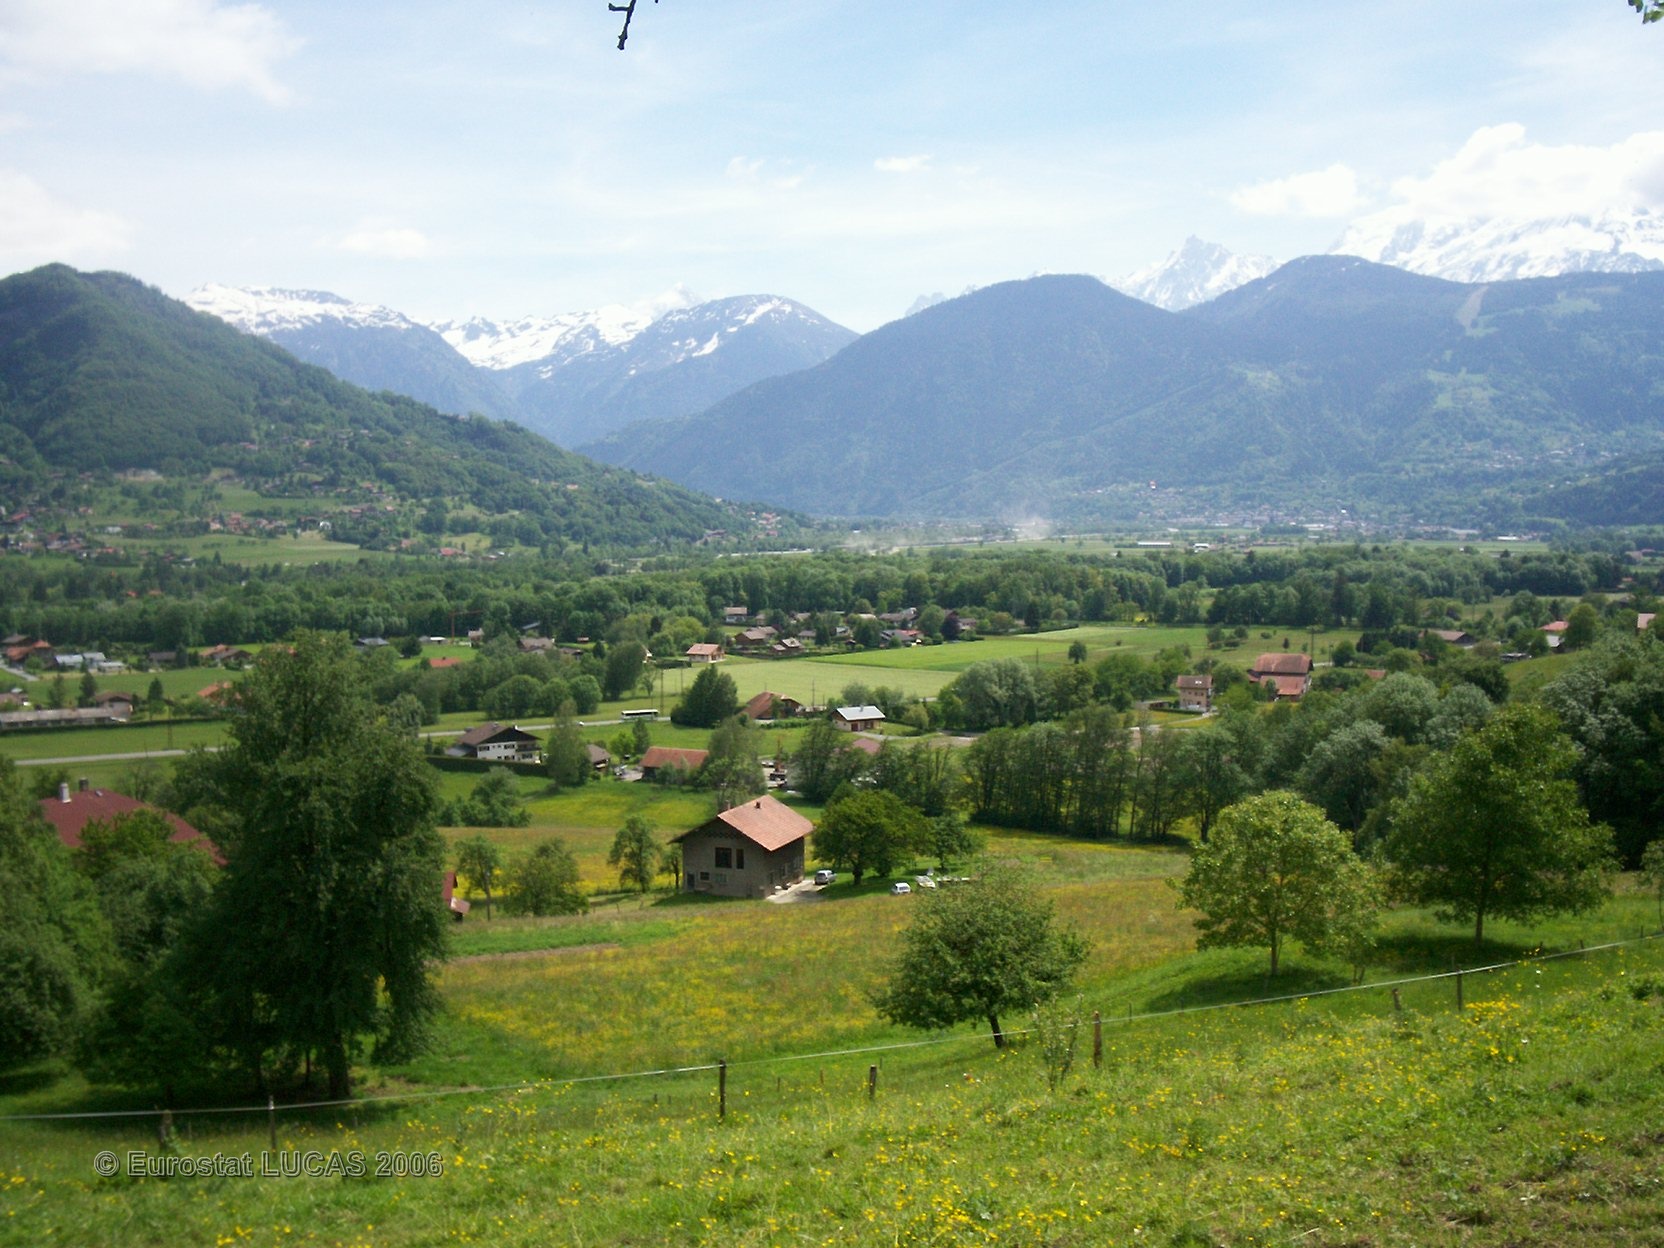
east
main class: Grassland
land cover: Grassland with sparse tree/shrub cover
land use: Agriculture (excluding fallow land and kitchen gardens)
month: May
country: FR
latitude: 45.9198
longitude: 6.6386
